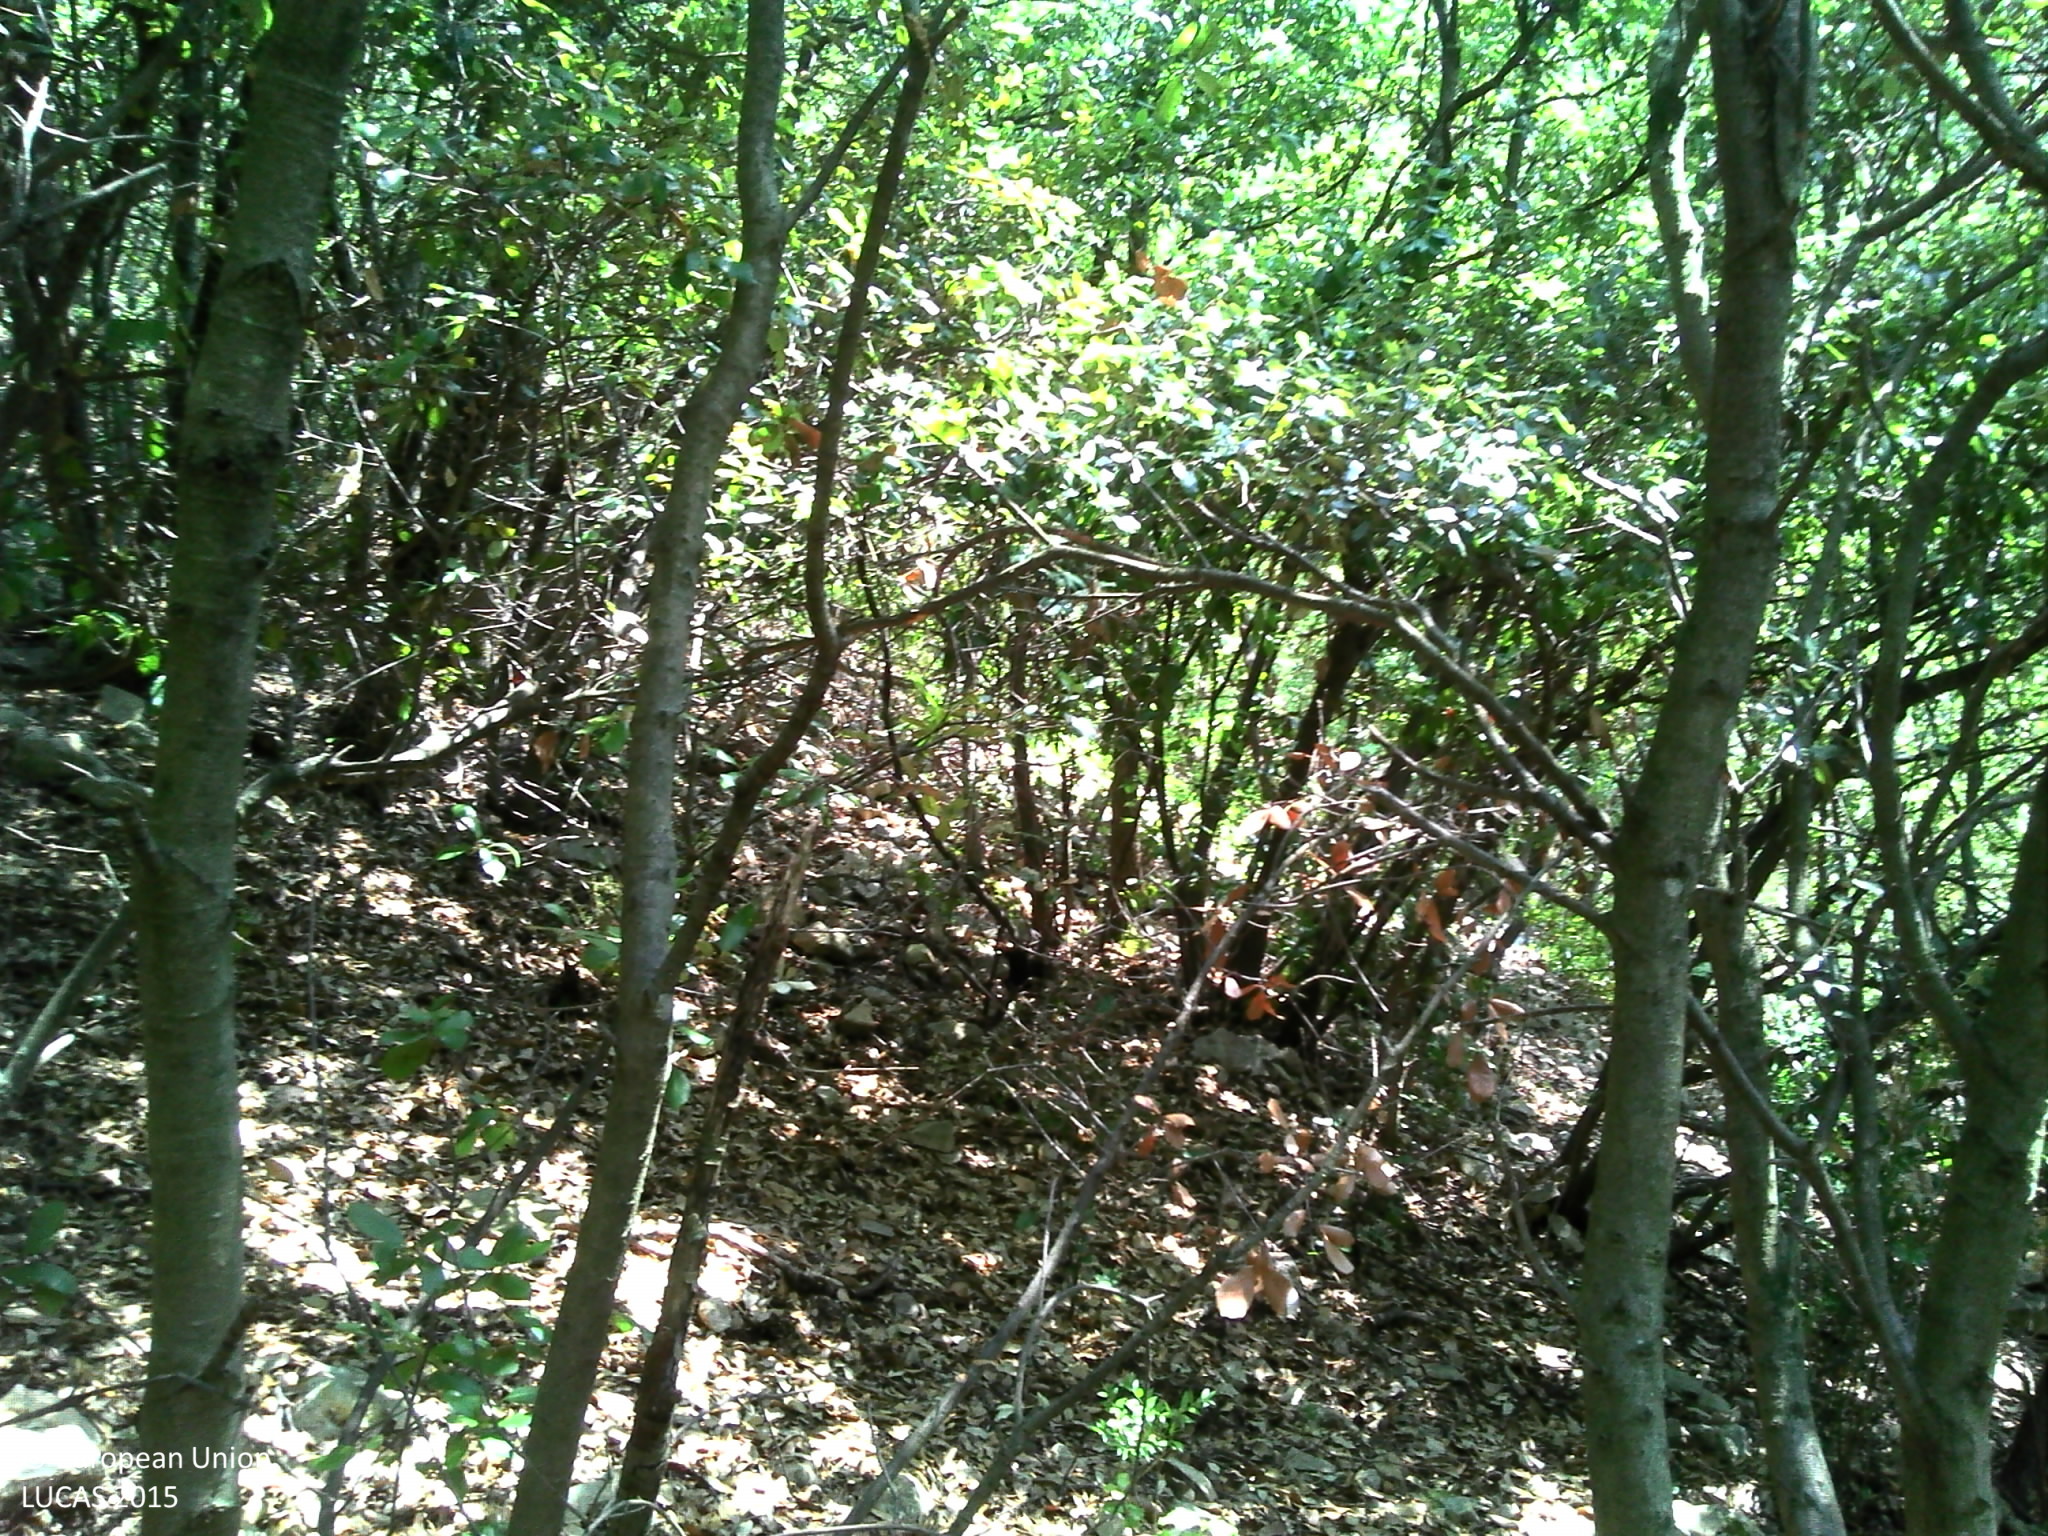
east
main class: Woodland
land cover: Broadleaved woodland
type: broadleaved evergreen forest
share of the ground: > 75 %
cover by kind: broadleaved forest trees 70 %, shrubs 15 %, coniferous forest trees 10 %, unconsolidated bare surface 5 %
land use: Semi-natural and natural areas not in use
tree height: > 5 m
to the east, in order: Broadleaved woodland; Other bare soil; Rock outcrops; Broadleaved woodland
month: July
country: FR
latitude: 44.0612
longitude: 5.2519
